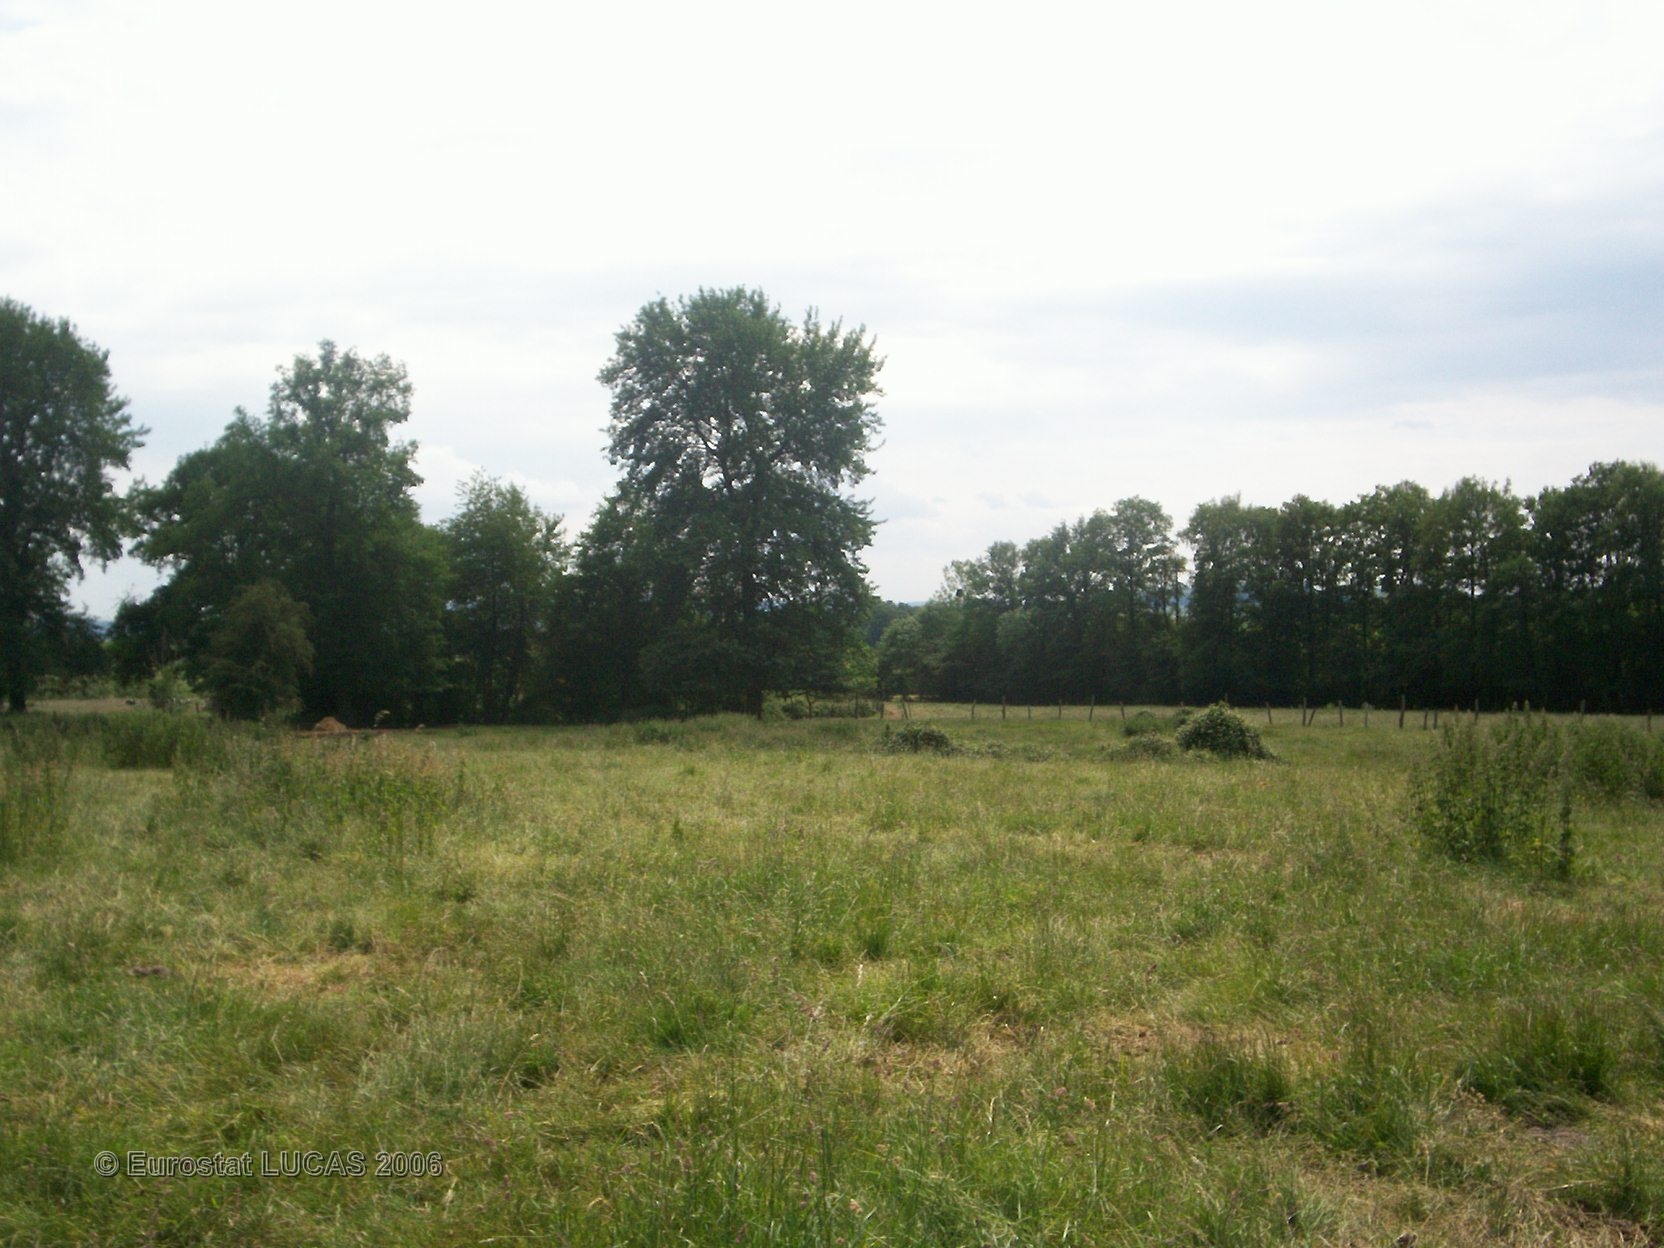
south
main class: Grassland
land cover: Grassland with sparse tree/shrub cover
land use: Agriculture (excluding fallow land and kitchen gardens)
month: June
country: FR
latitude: 49.4065
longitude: 2.6709
